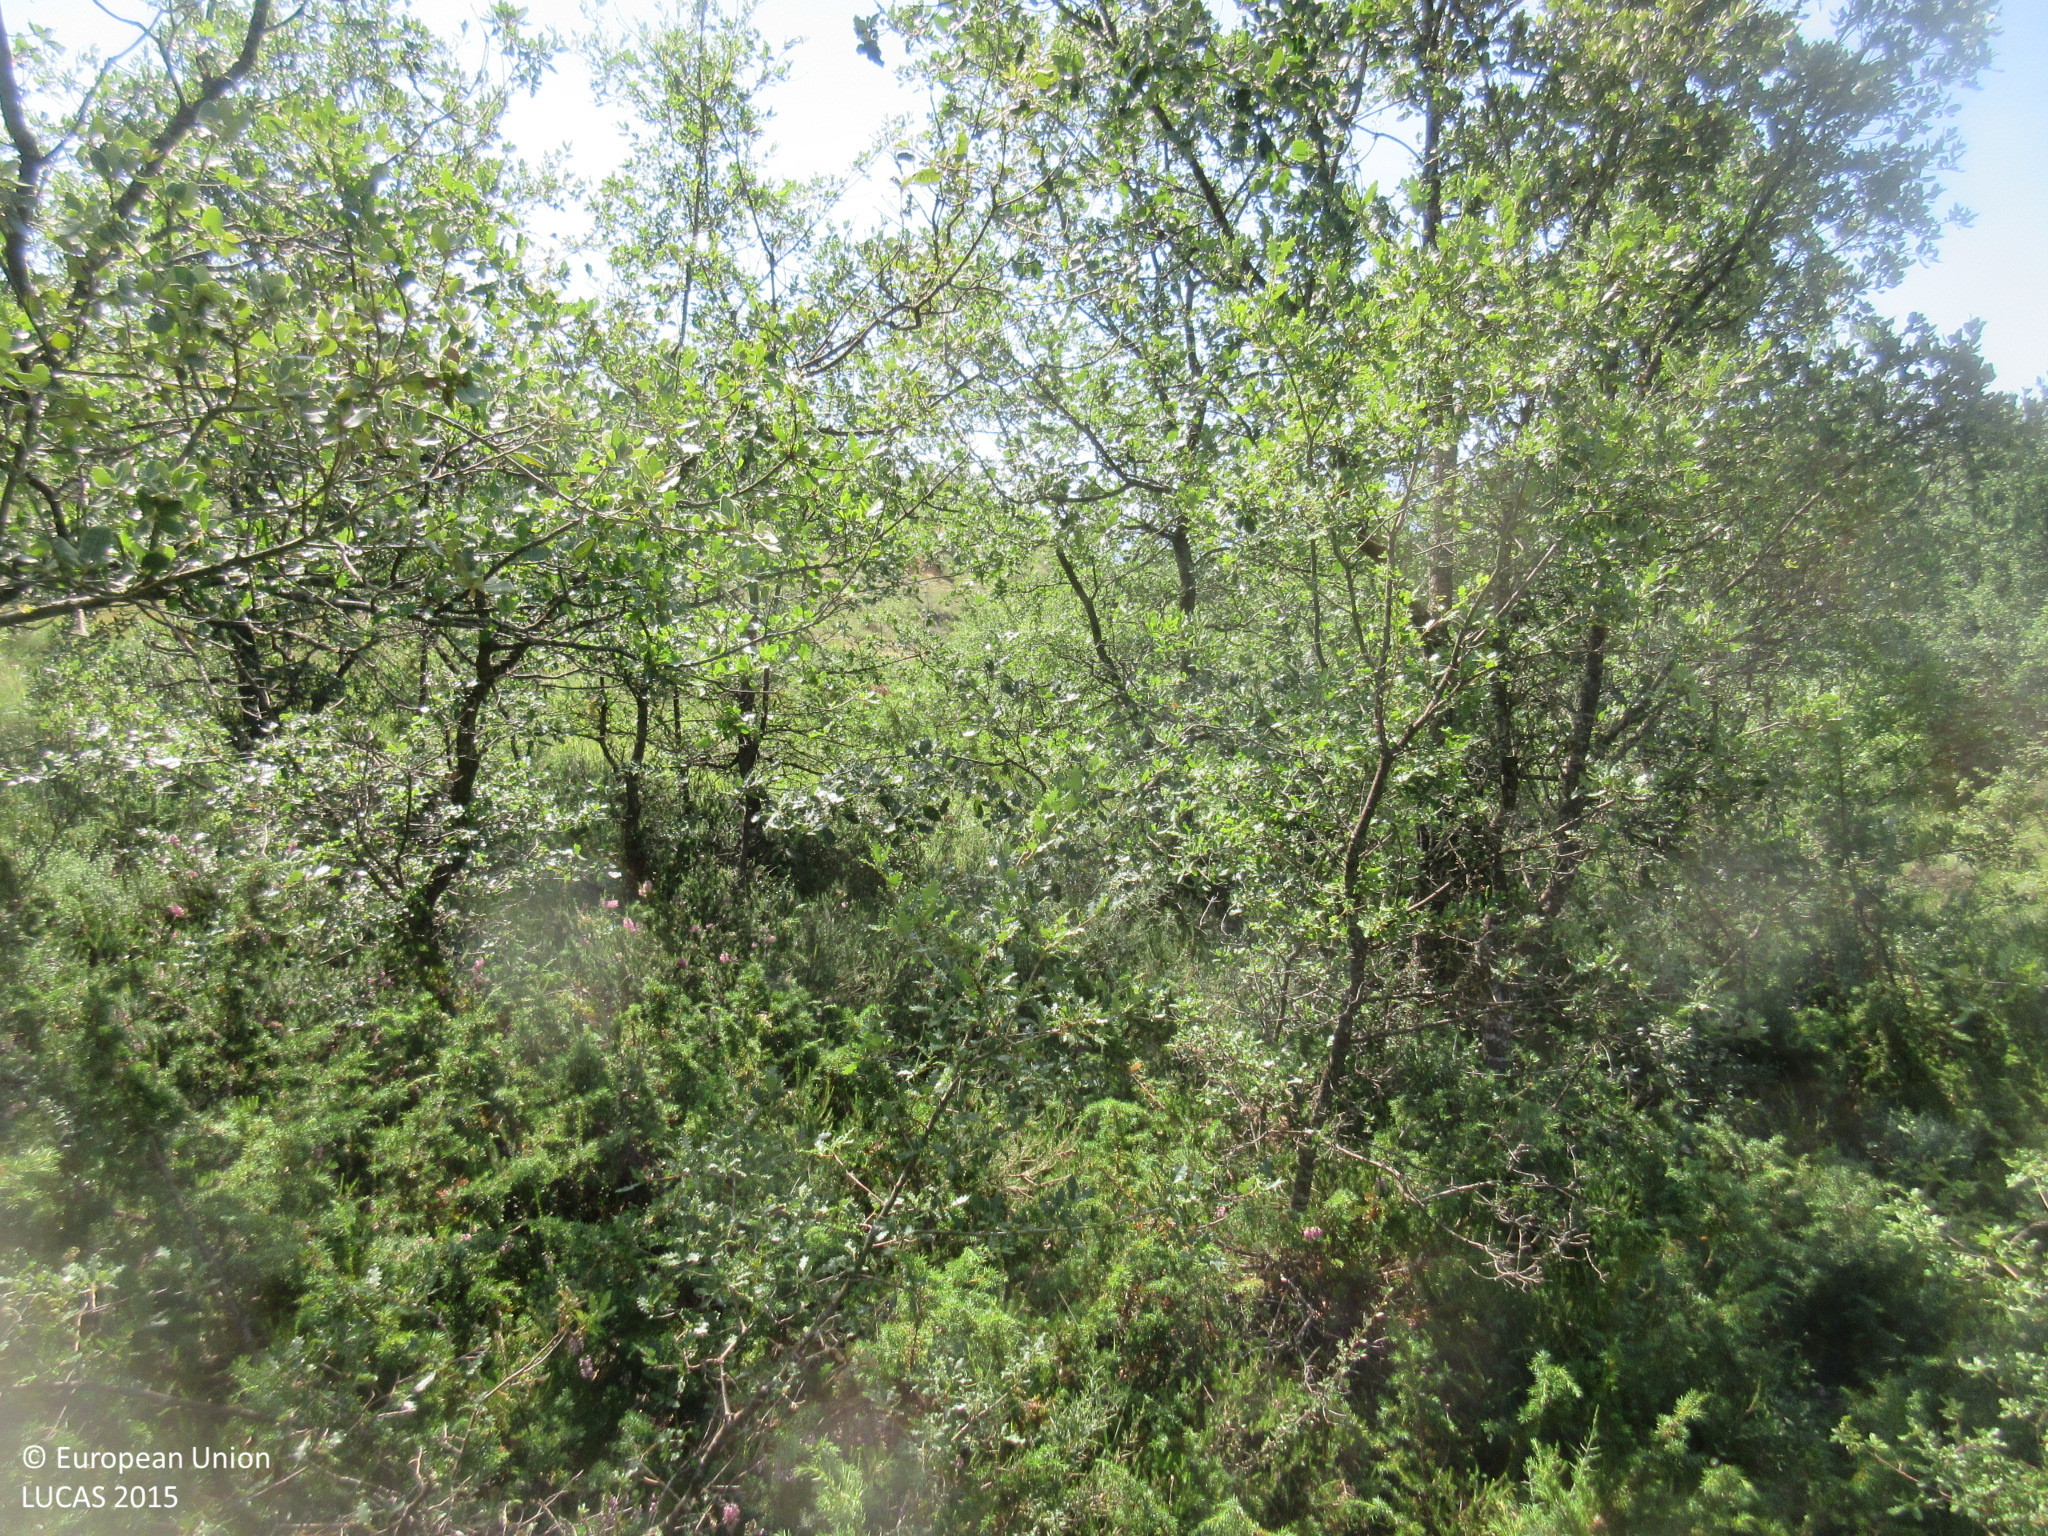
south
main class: Woodland
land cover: Broadleaved woodland
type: broadleaved evergreen forest
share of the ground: 50 - 75 %
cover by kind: broadleaved forest trees 70 %, shrubs 15 %, herbaceous plants 15 %
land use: Semi-natural and natural areas not in use
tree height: < 5 m
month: July
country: ES
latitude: 42.9475
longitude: -3.5341
